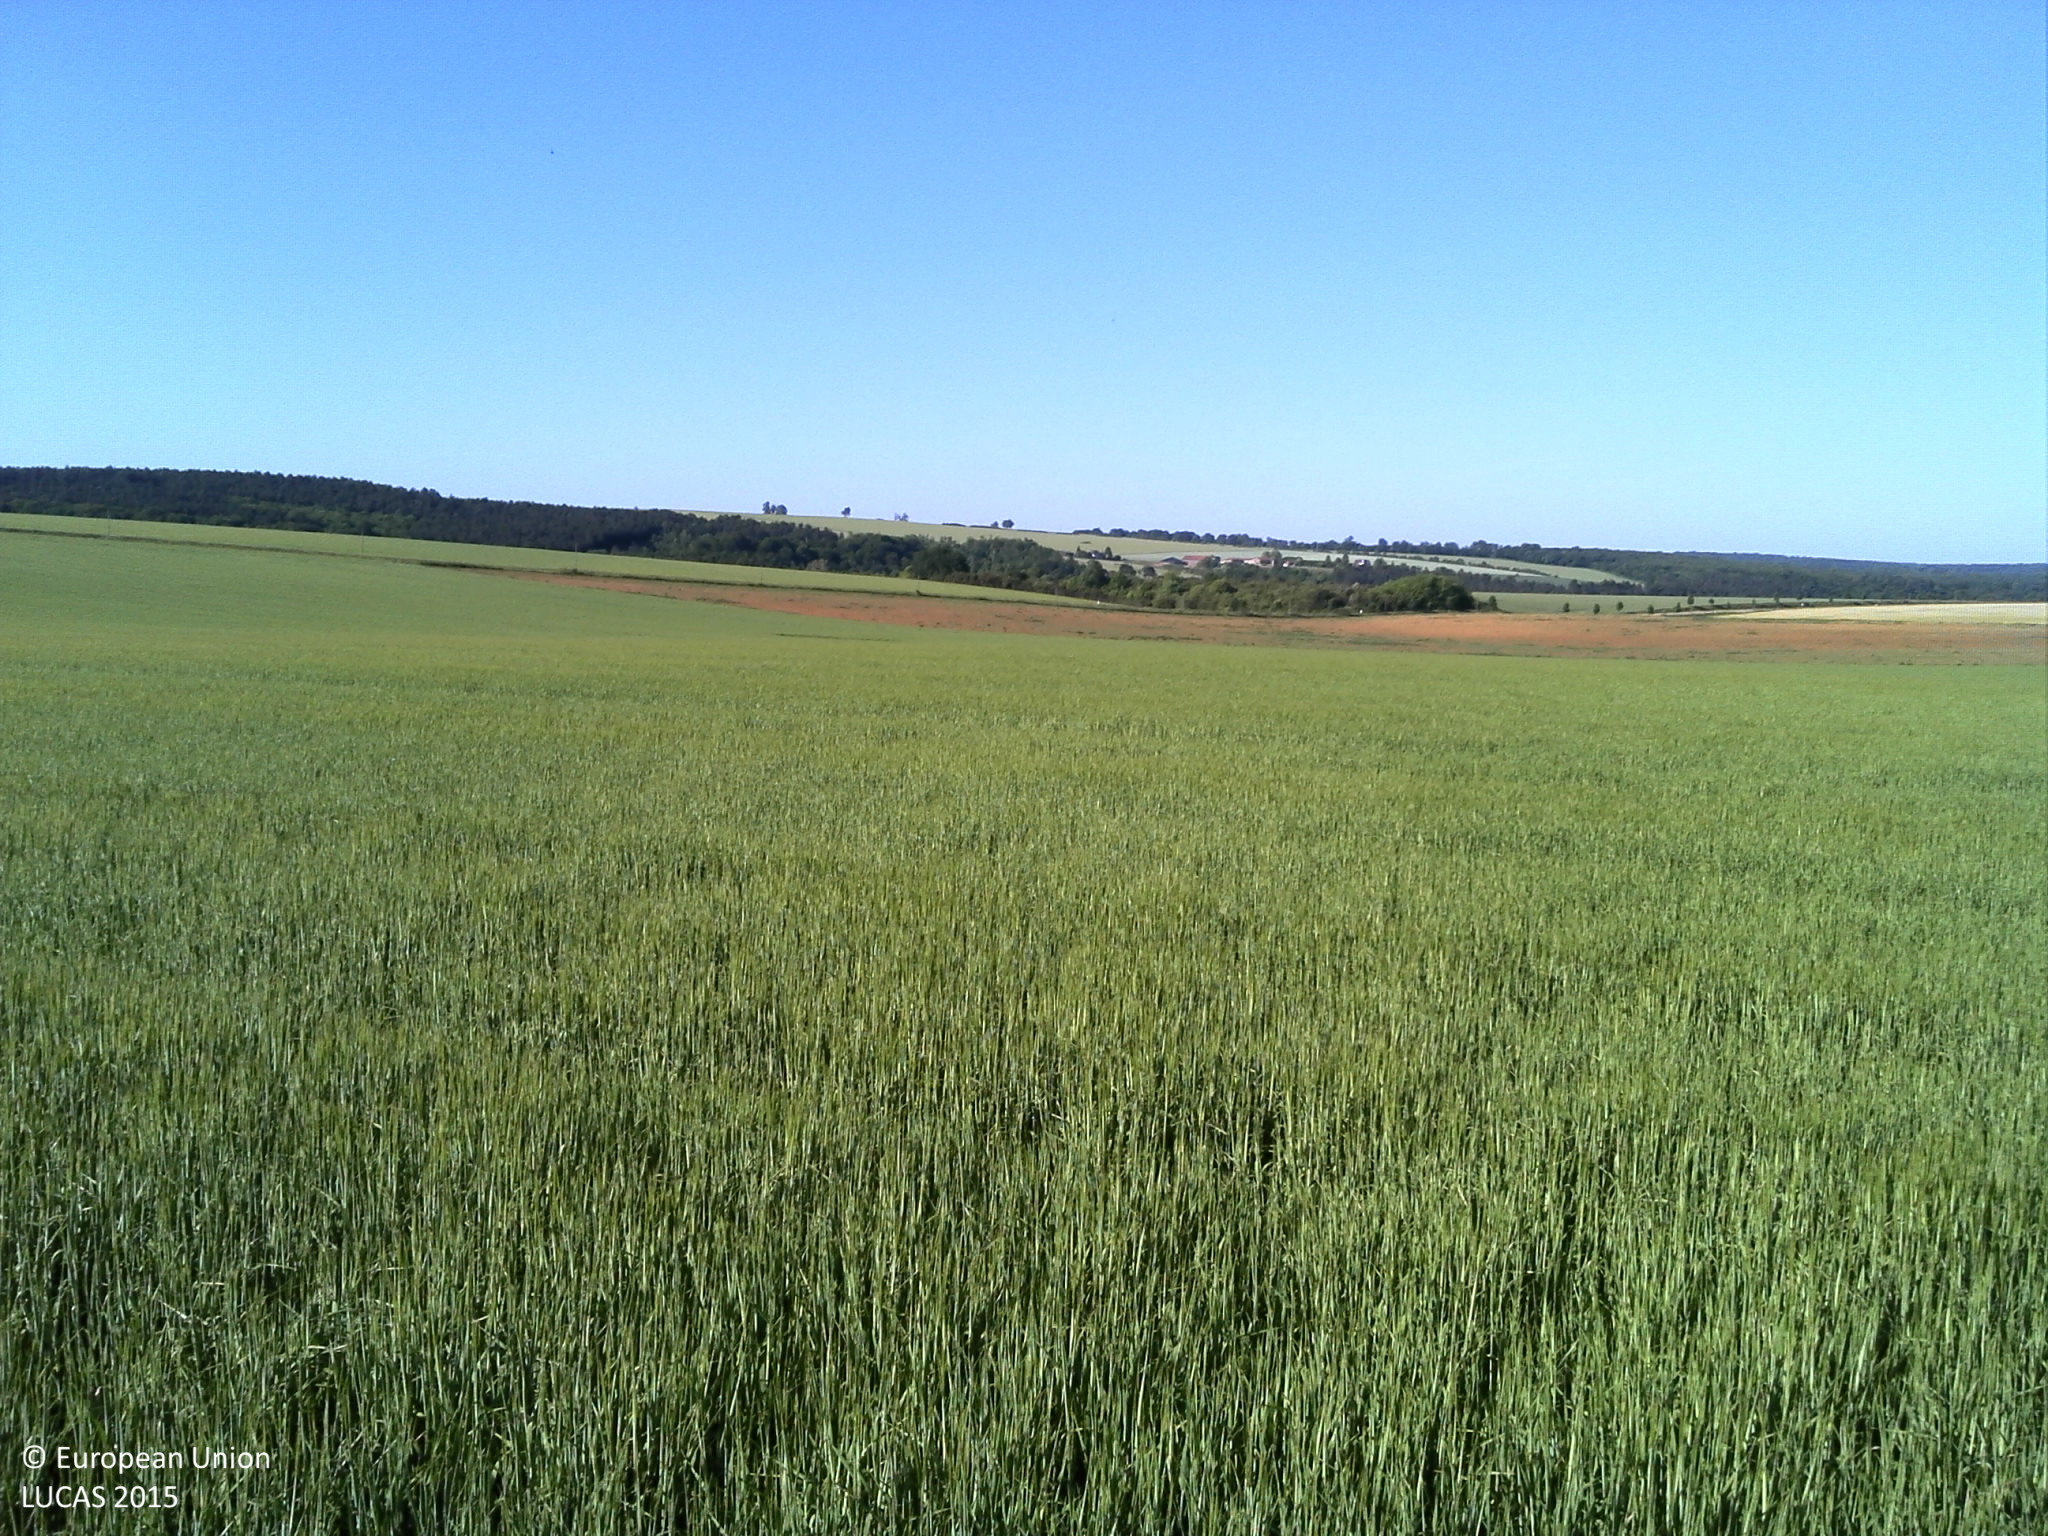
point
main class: Cropland
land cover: Barley
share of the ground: > 75 %
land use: Agriculture (excluding fallow land and kitchen gardens)
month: June
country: FR
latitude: 49.0504
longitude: 5.9631
